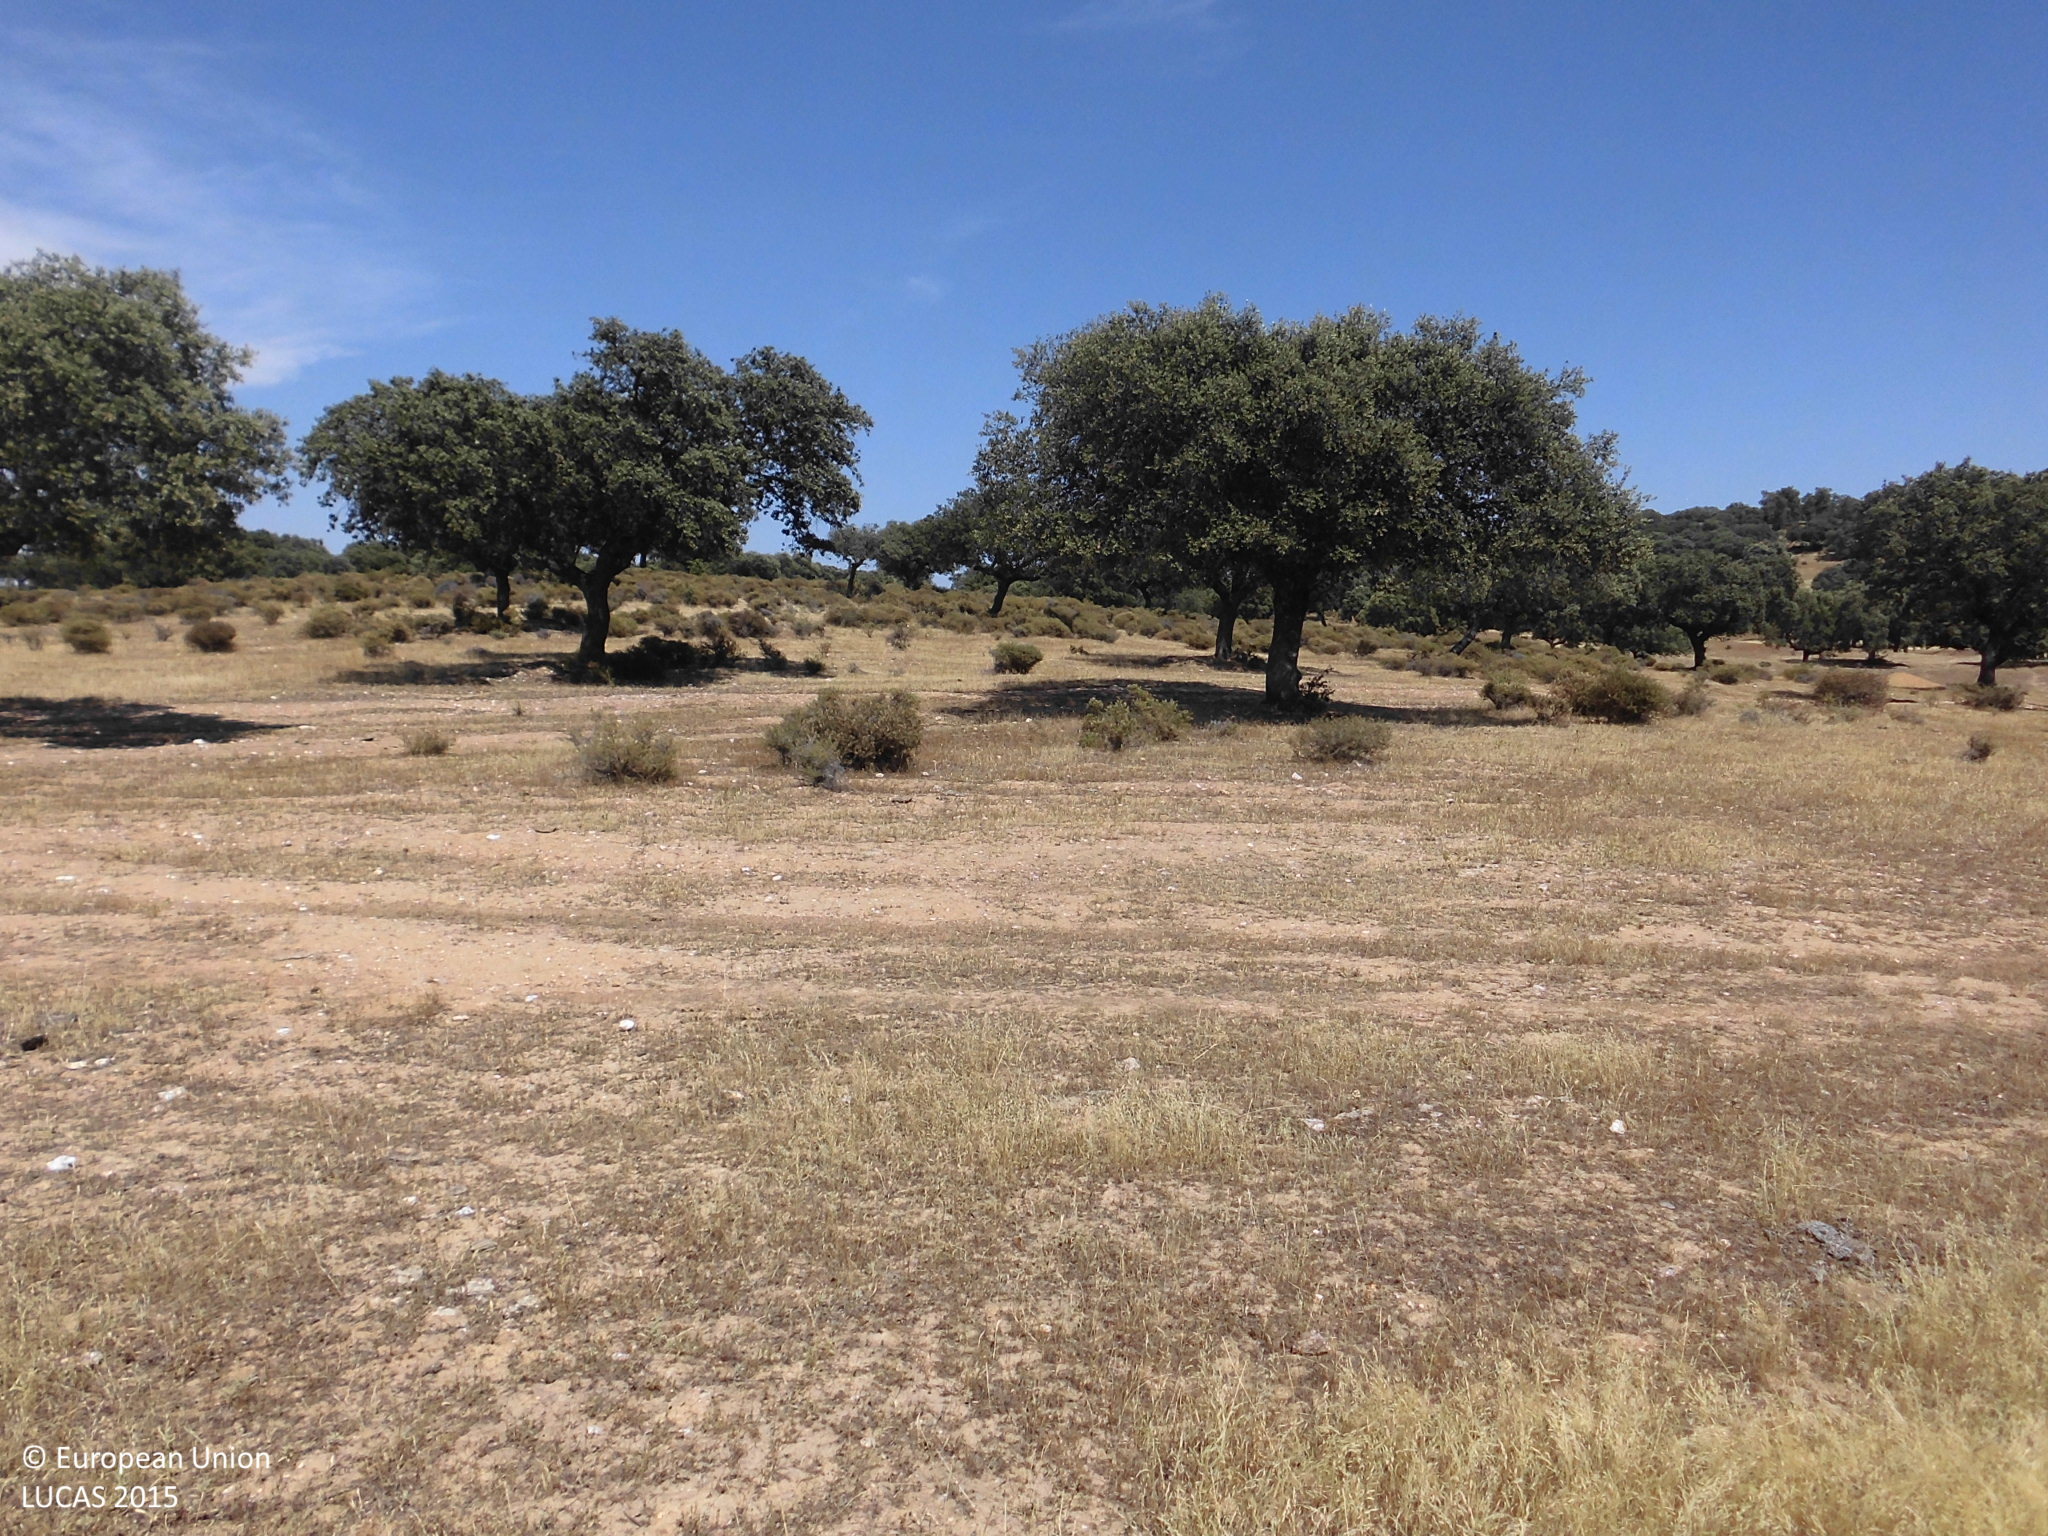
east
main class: Woodland
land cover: Broadleaved woodland
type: broadleaved evergreen forest
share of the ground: 10 - 25 %
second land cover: Grassland without tree/shrub cover
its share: > 75 %
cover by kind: herbaceous plants 90 %, broadleaved forest trees 10 %
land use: Forestry
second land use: Agriculture (excluding fallow land and kitchen gardens)
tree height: > 5 m
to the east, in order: Broadleaved woodland; Grassland without tree/shrub cover; Broadleaved woodland
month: June
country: ES
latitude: 39.7496
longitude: -6.1386
